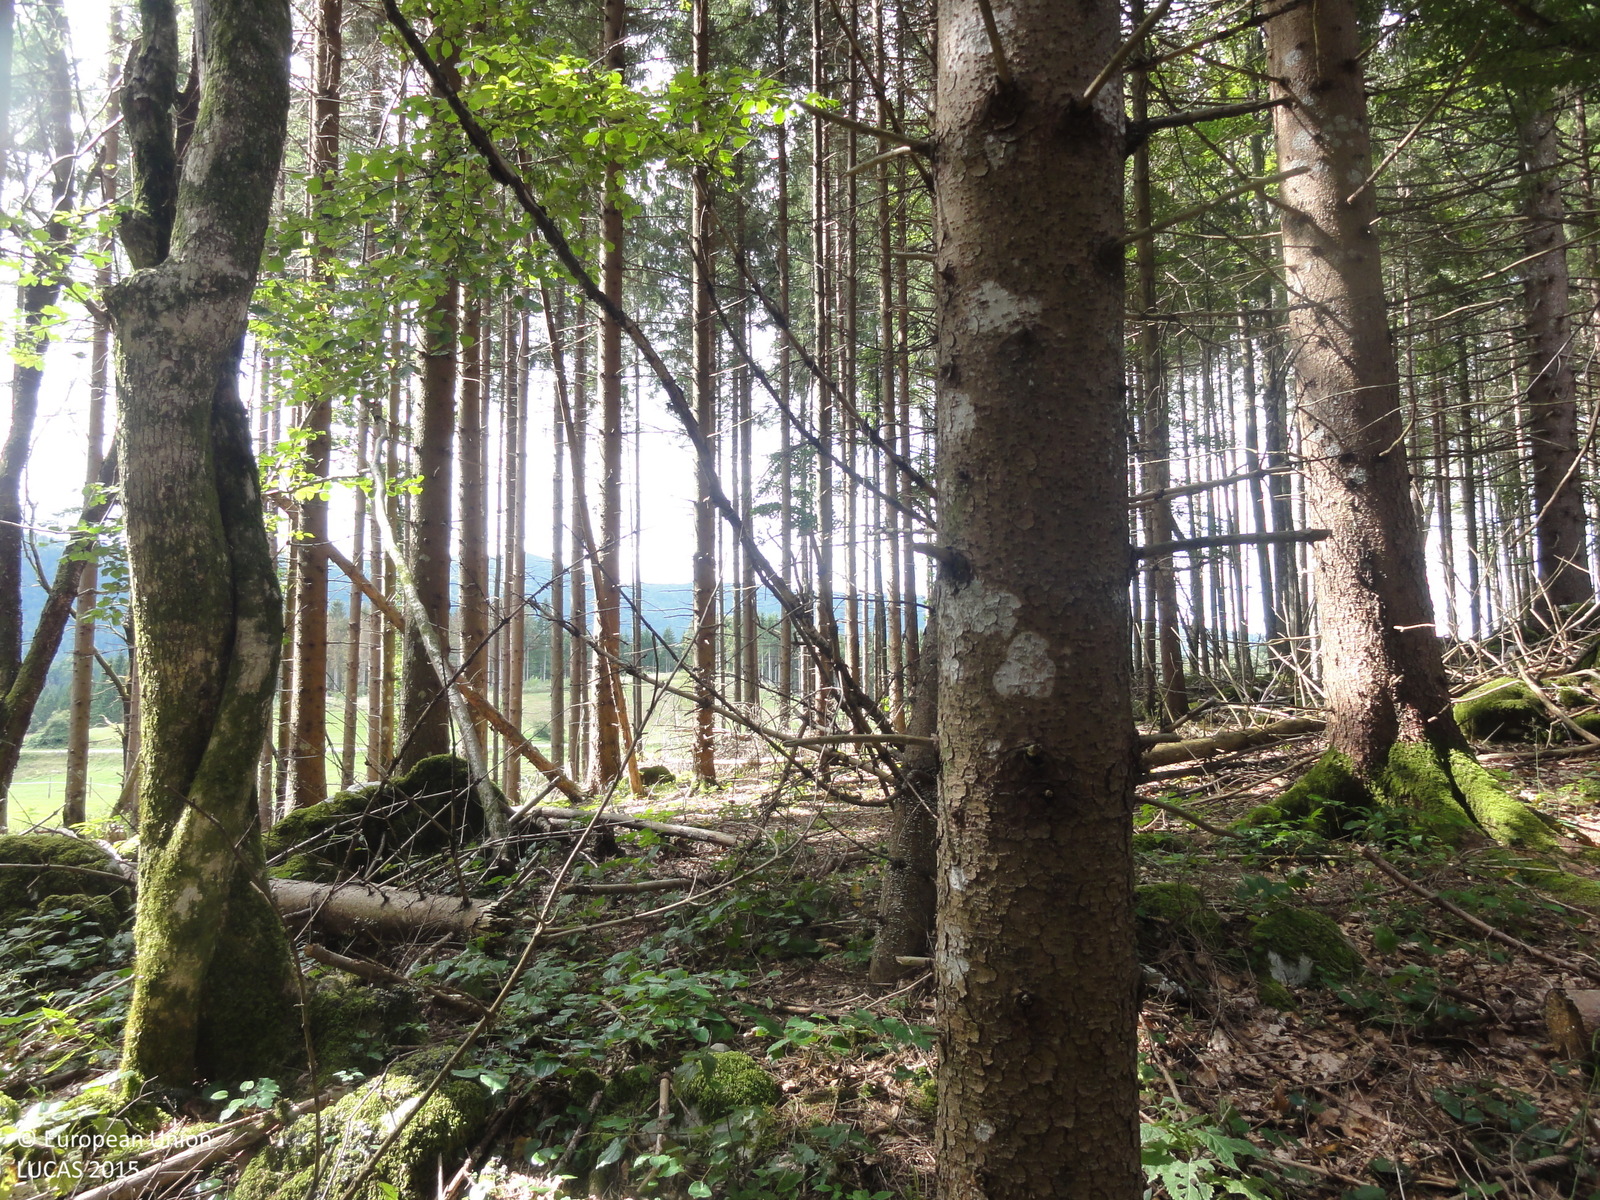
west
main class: Woodland
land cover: Spruce dominated mixed woodland
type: hemiboreal forest and nemoral coniferous forest and mixed broadleaved-coniferous forest
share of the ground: > 75 %
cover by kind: coniferous forest trees 60 %, broadleaved forest trees 25 %, herbaceous plants 5 %
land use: Forestry
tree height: > 5 m
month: September
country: SI
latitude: 45.5937
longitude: 14.8028
